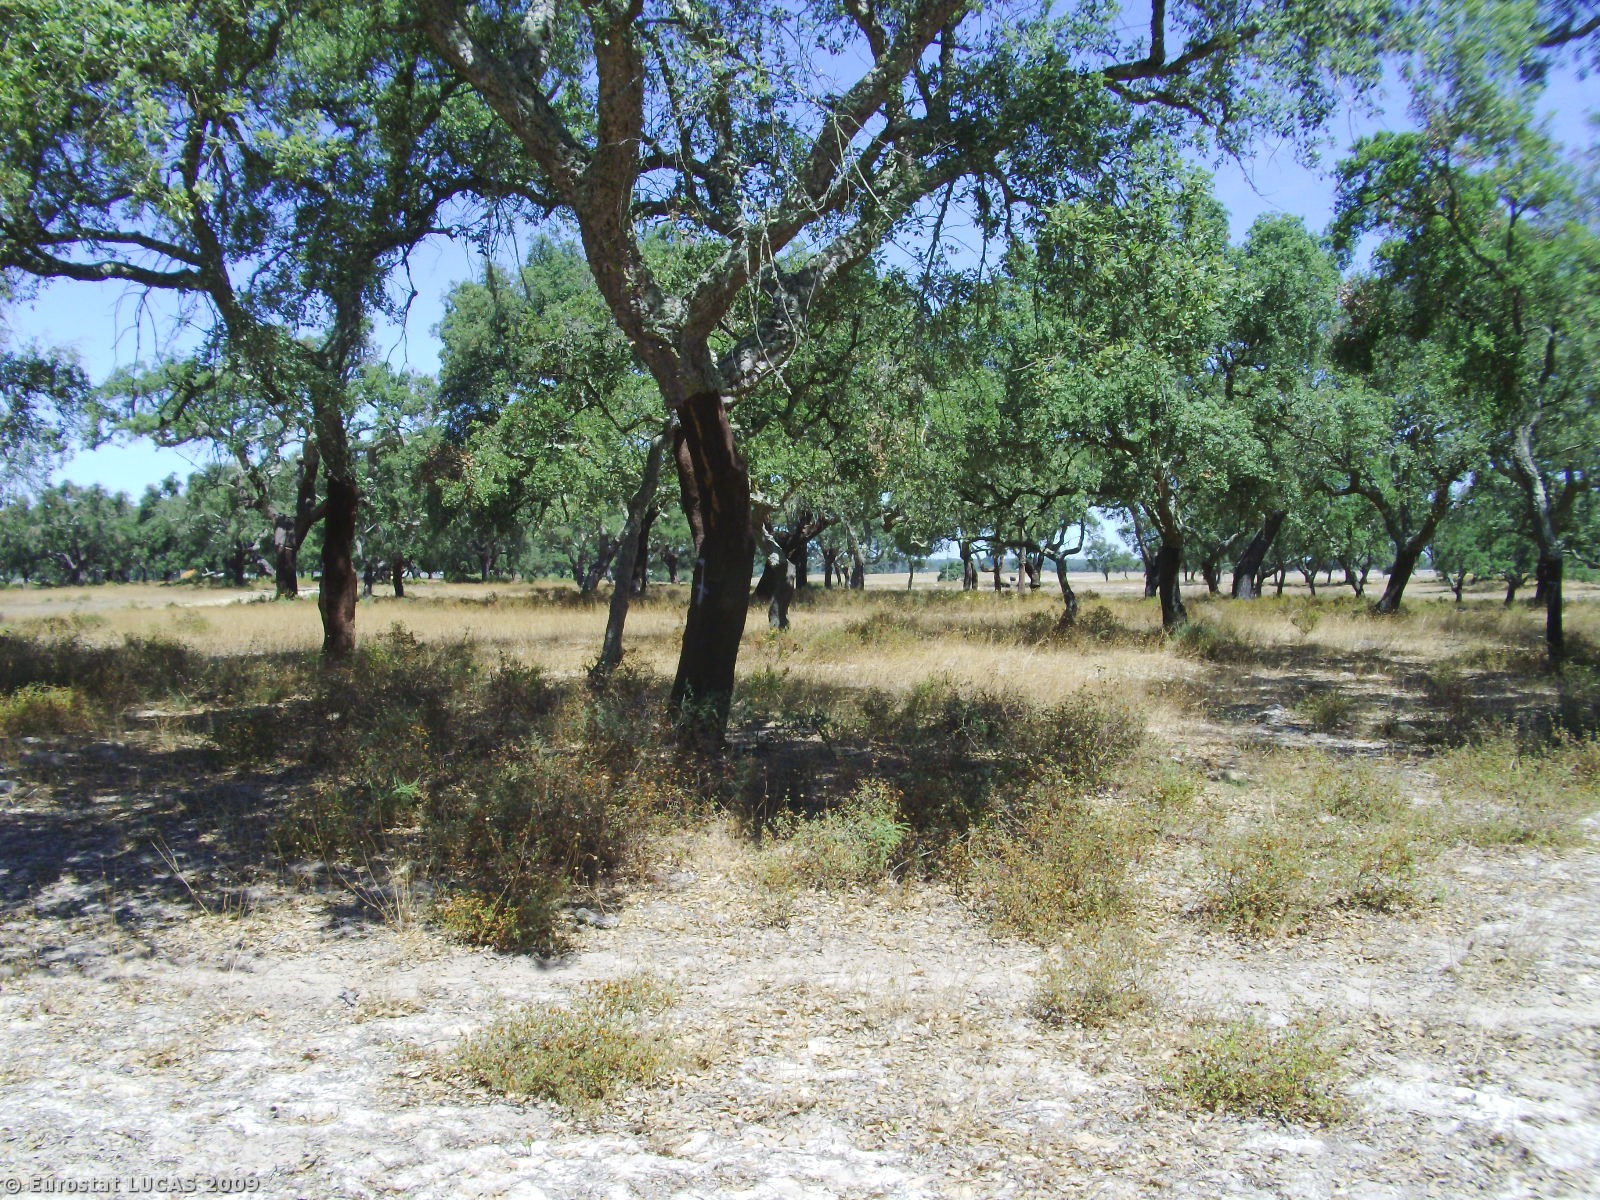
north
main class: Woodland
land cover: Broadleaved woodland
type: broadleaved evergreen forest
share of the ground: 10 - 25 %
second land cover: Spontaneously vegetated surfaces
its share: 50 - 75 %
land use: Forestry
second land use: Fallow land
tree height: > 5 m
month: August
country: PT
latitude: 38.7311
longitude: -8.8757
